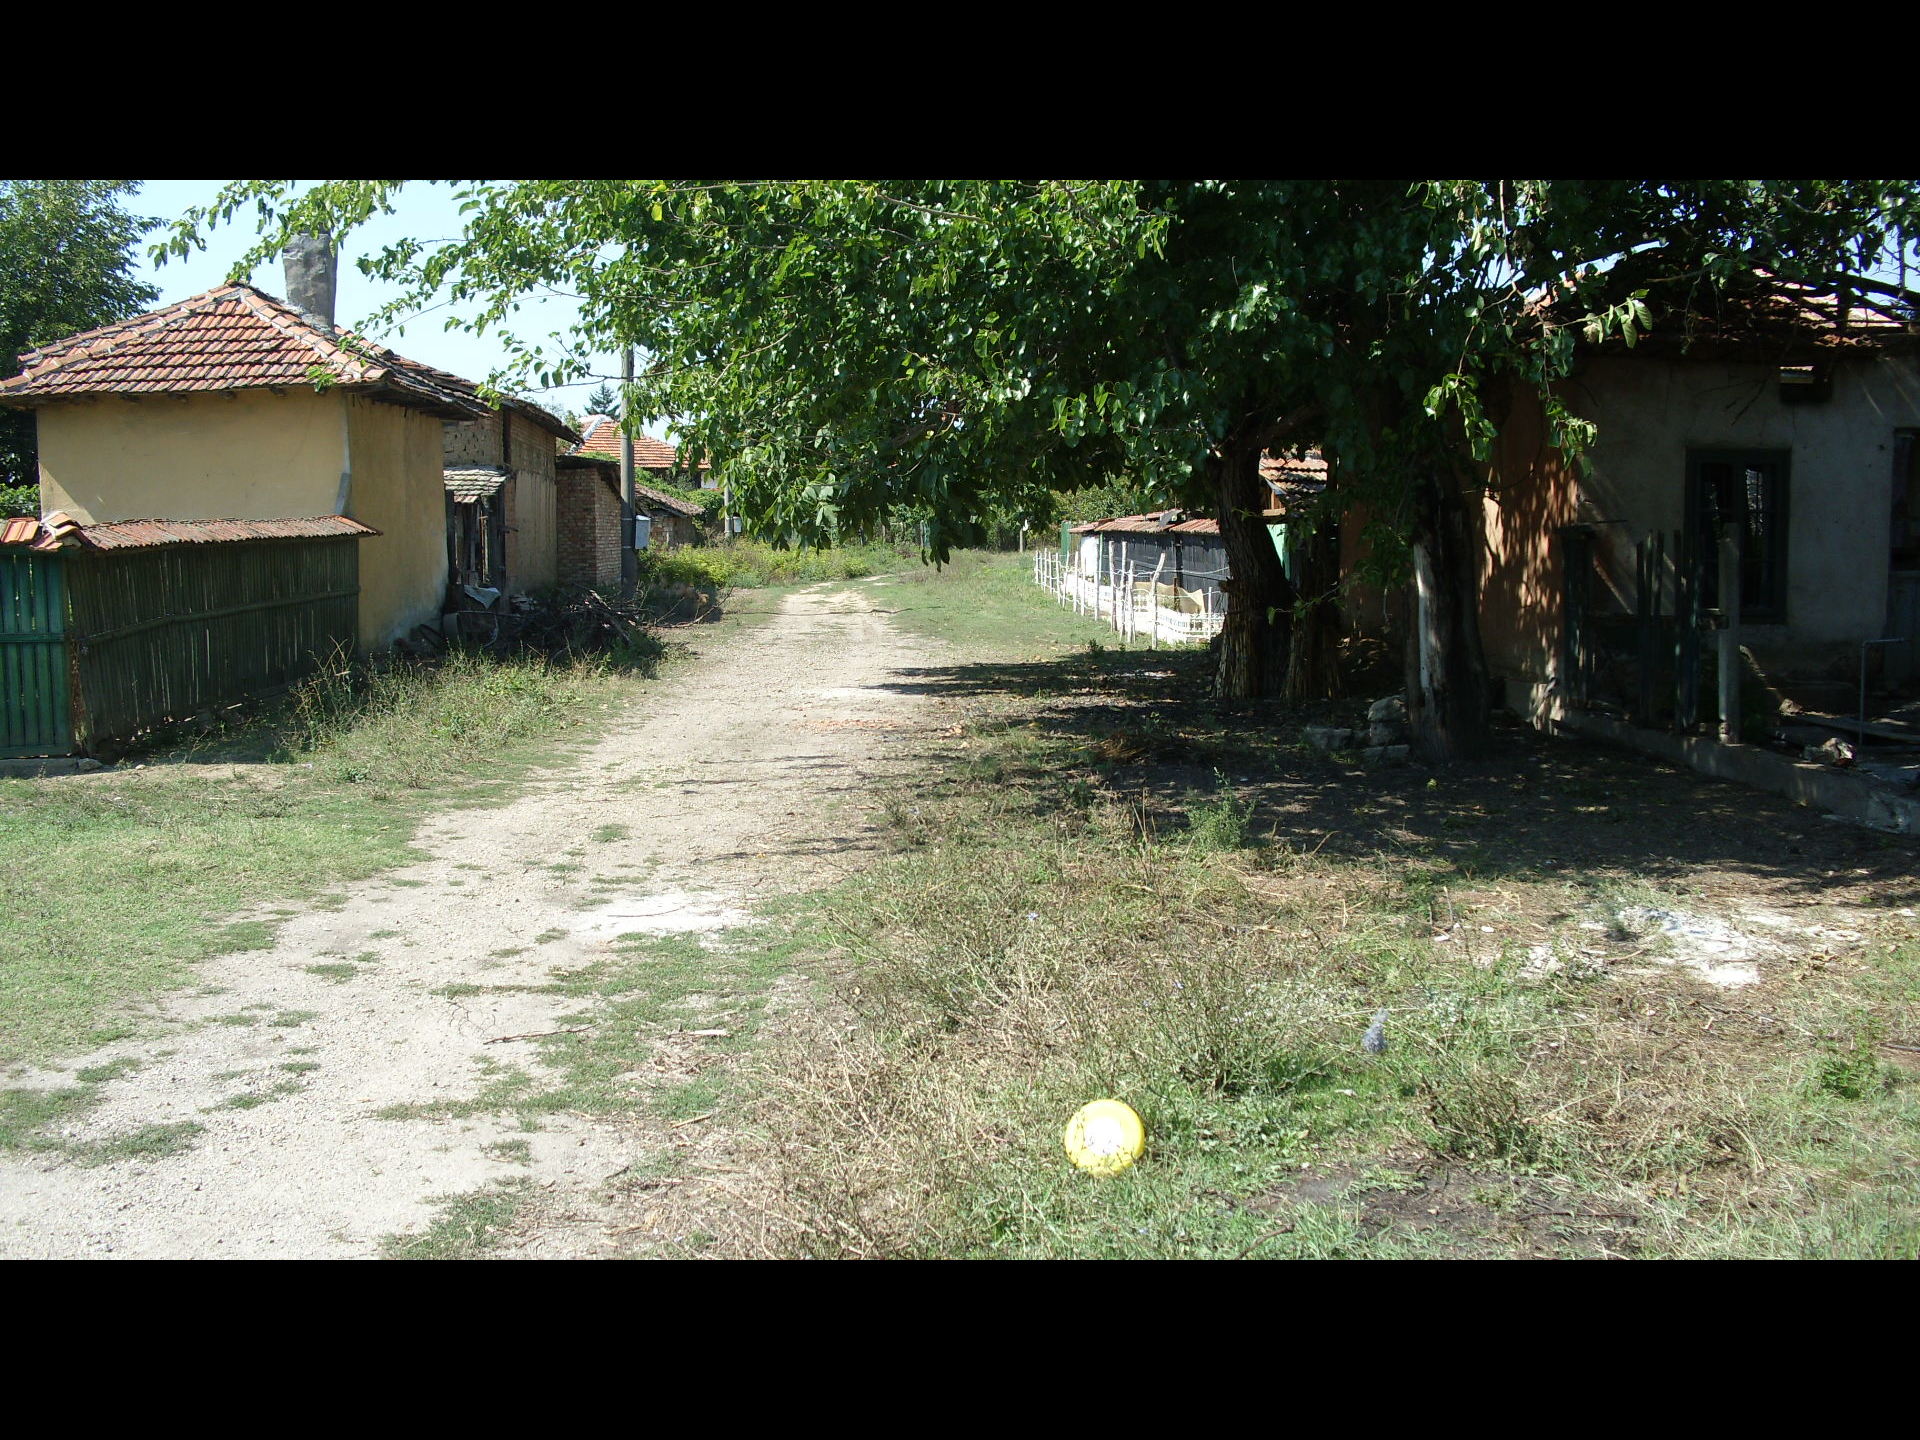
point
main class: Grassland
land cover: Grassland with sparse tree/shrub cover
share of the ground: > 75 %
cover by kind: herbaceous plants 90 %, broadleaved forest trees 5 %, shrubs 5 %
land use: Residential
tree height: > 5 m
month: August
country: BG
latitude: 44.1206
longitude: 22.6461
